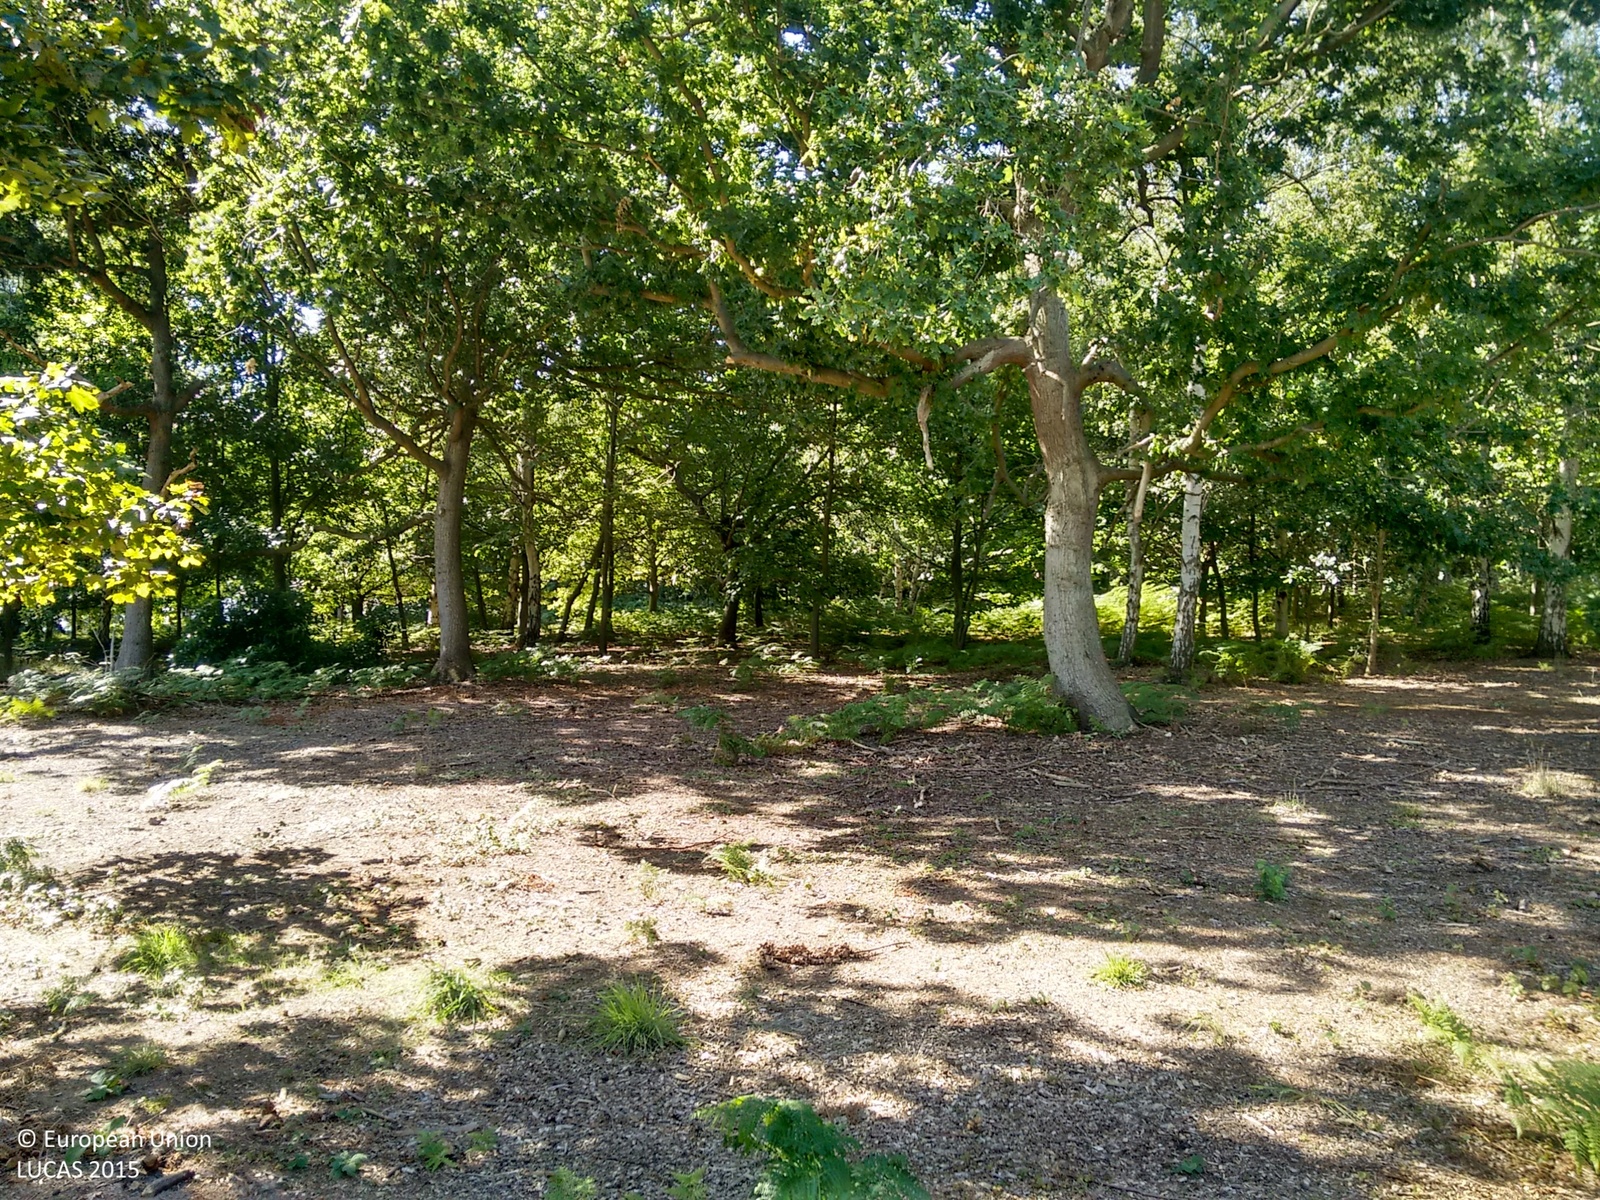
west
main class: Woodland
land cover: Broadleaved woodland
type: mesophytic deciduous forest
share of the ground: 25 - 50 %
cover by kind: herbaceous plants 70 %, broadleaved forest trees 30 %
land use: Forestry
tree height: > 5 m
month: September
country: GB
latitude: 52.1659
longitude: 1.5454
